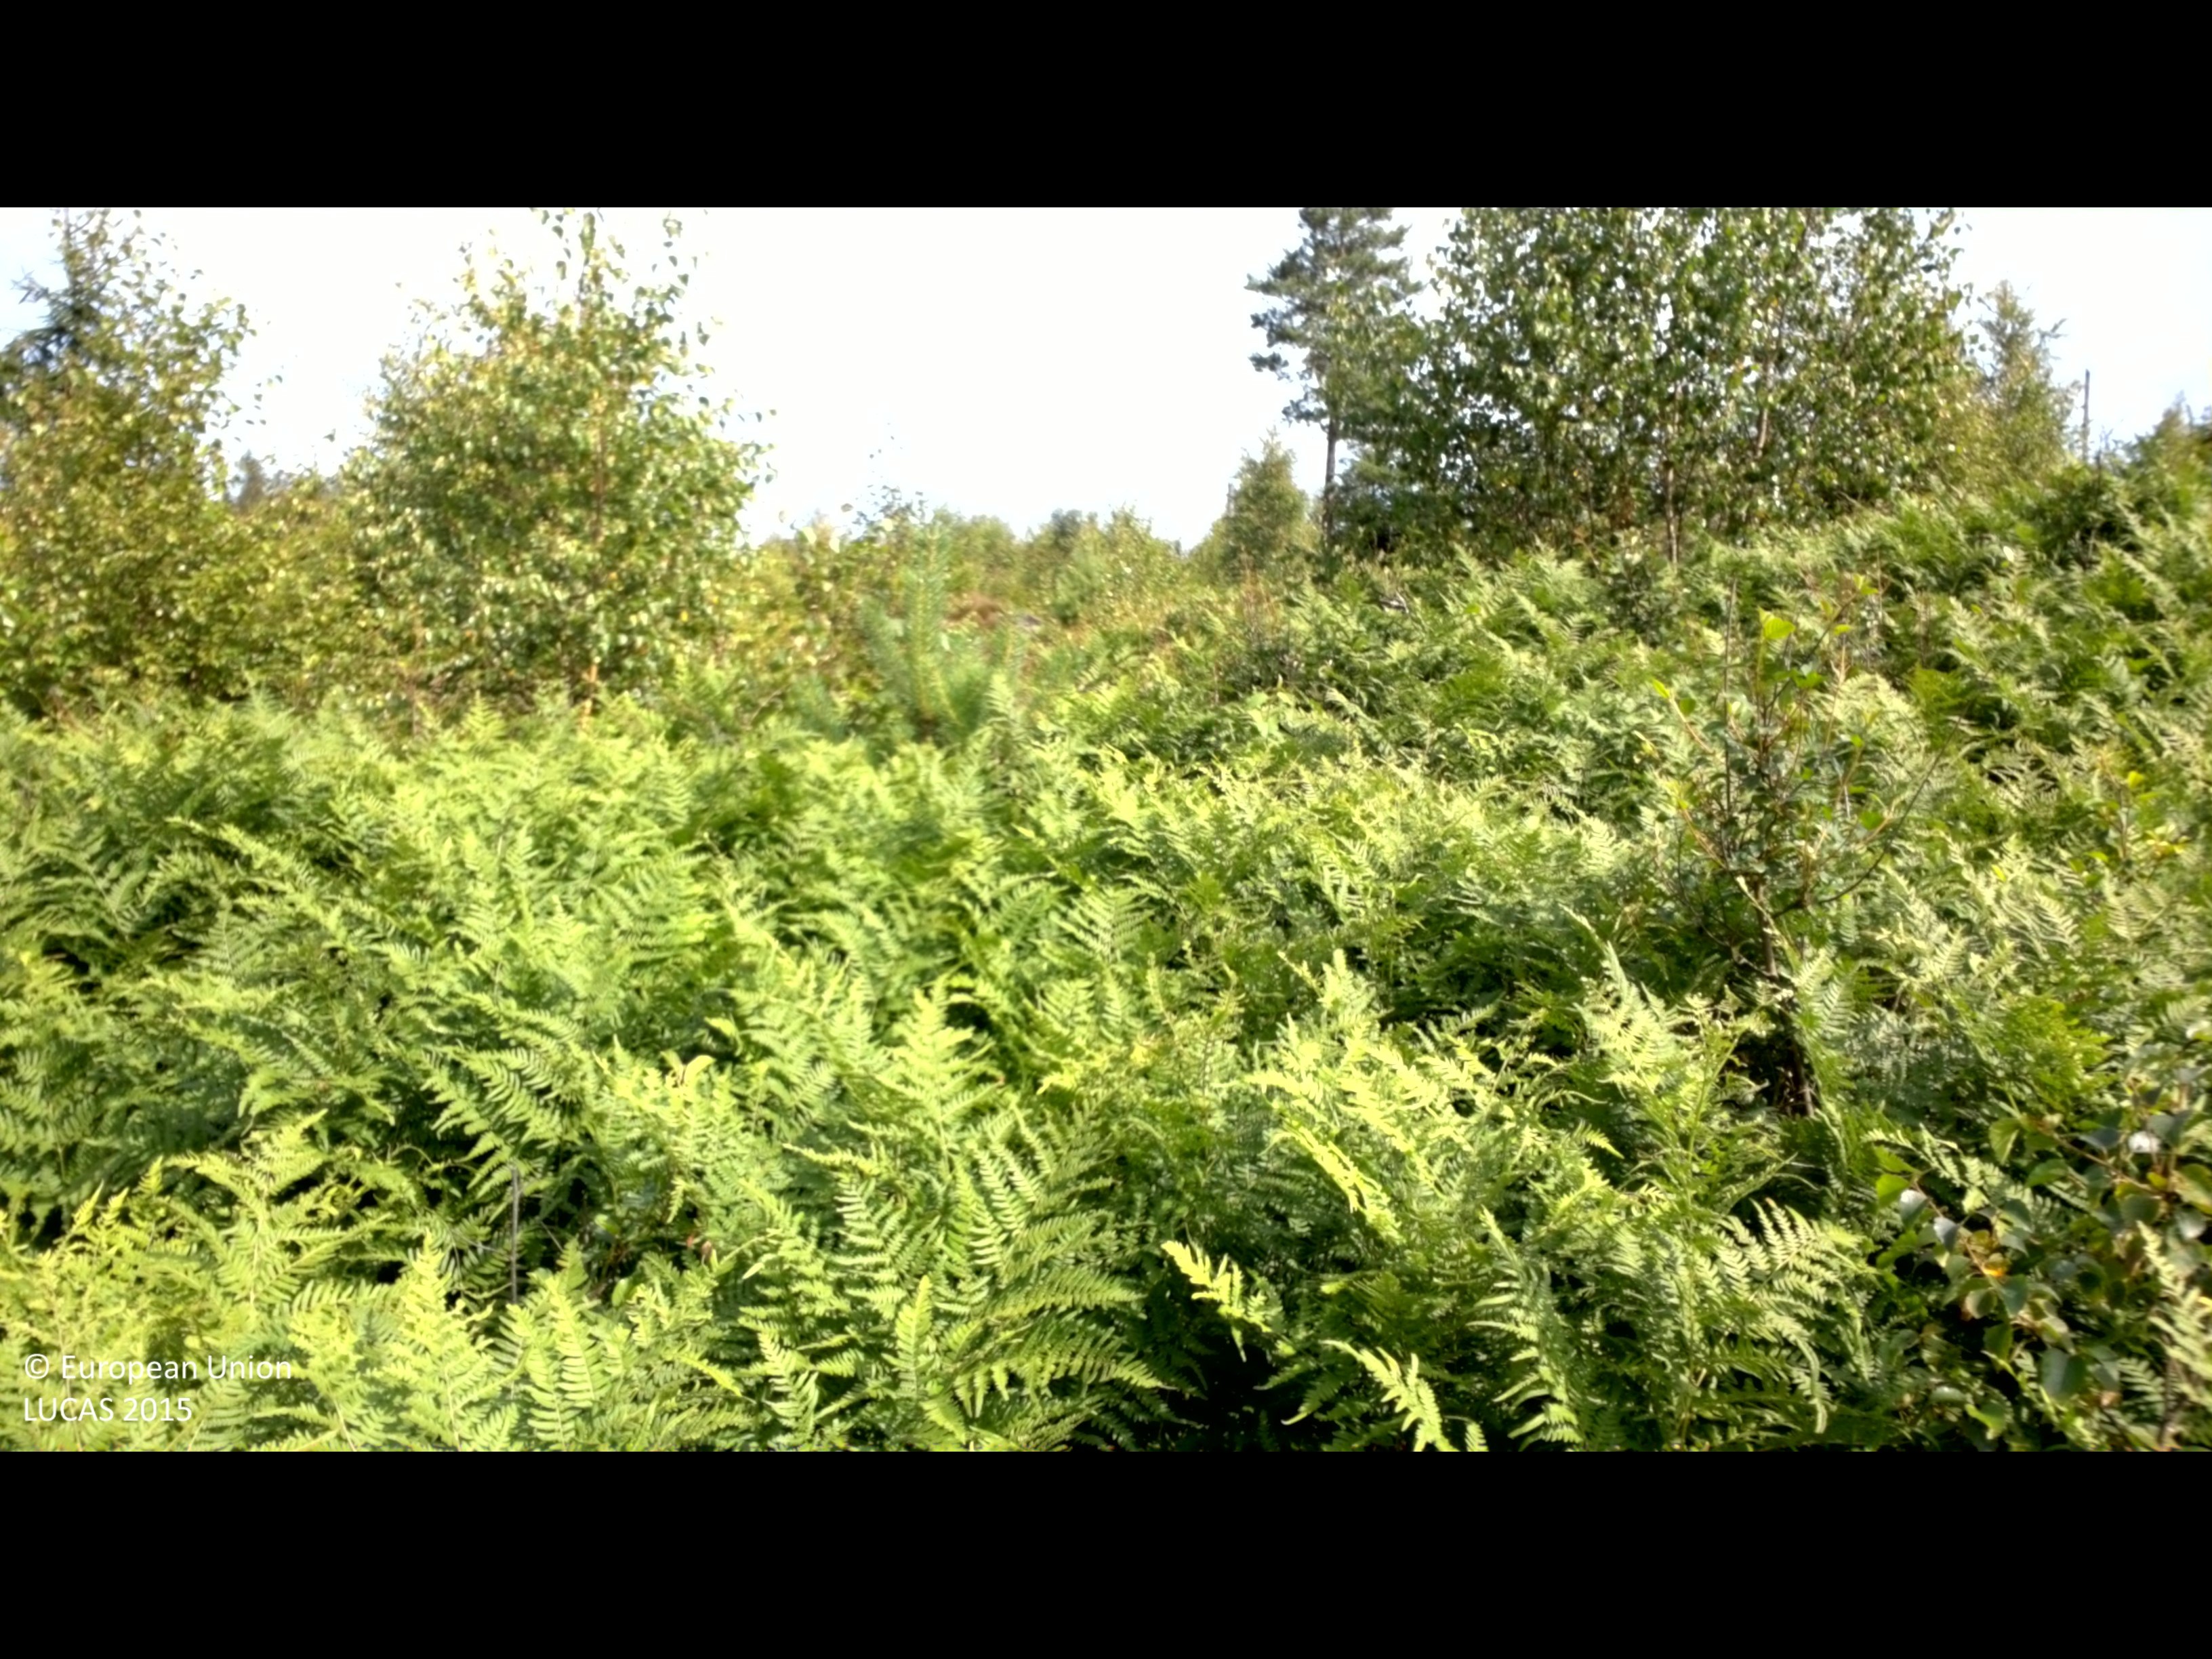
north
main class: Grassland
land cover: Grassland with sparse tree/shrub cover
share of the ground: > 75 %
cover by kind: herbaceous plants 85 %, shrubs 10 %, broadleaved forest trees 5 %
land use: Electricity, gas and thermal power distribution
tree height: < 5 m
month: August
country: SE
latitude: 56.4221
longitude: 14.2936
